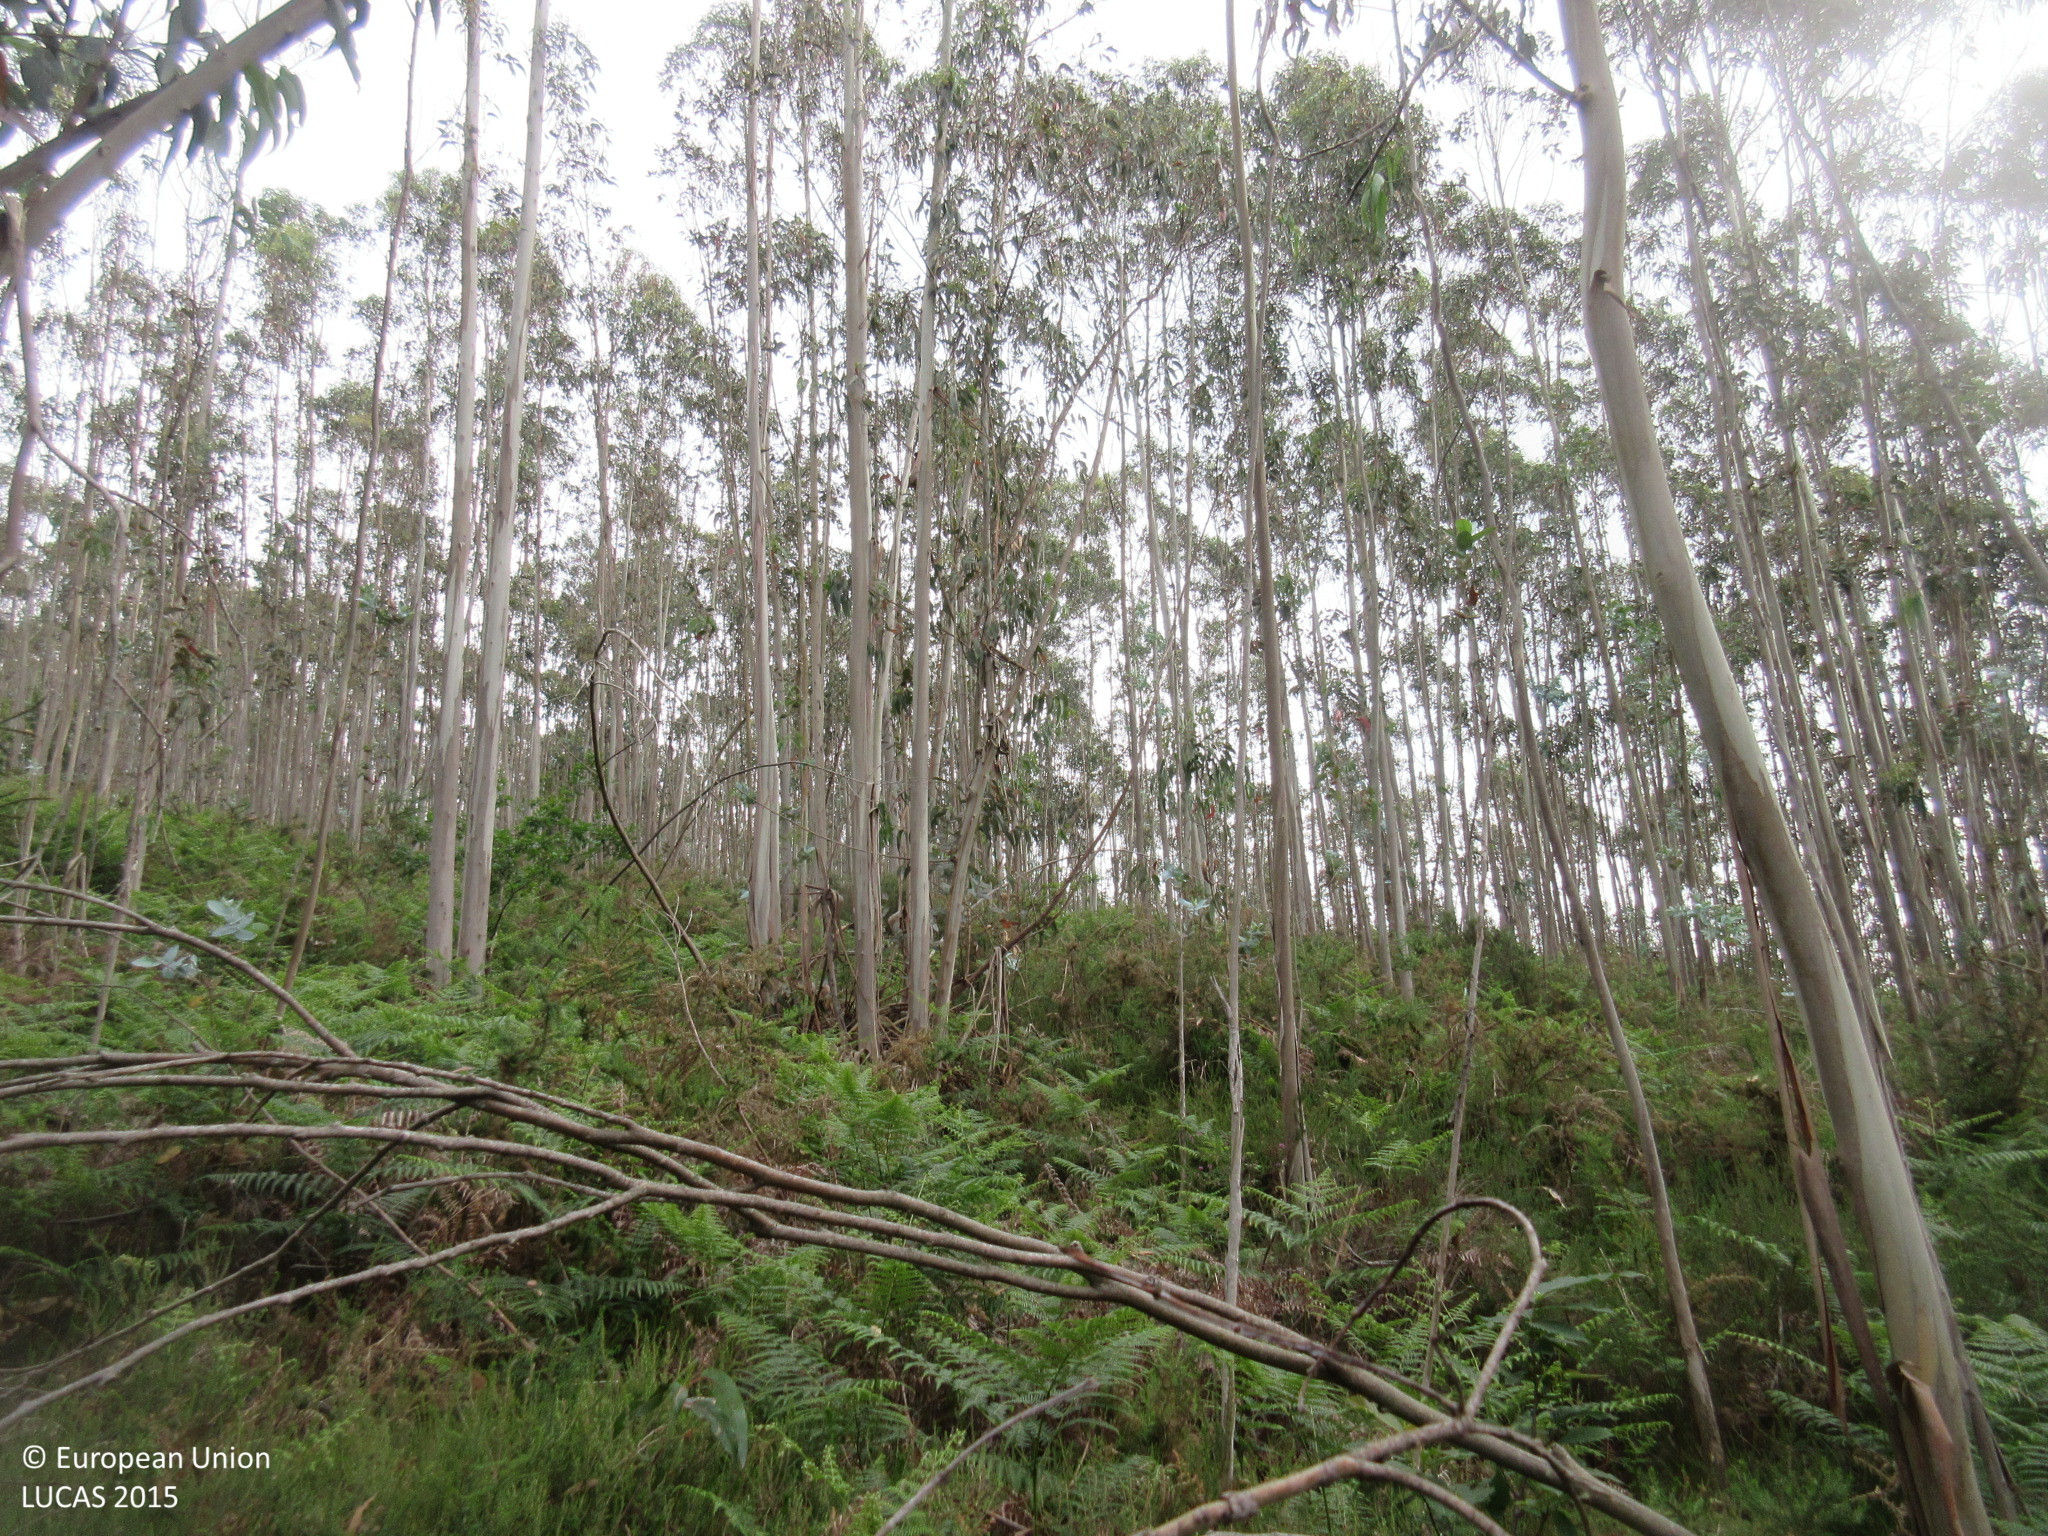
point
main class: Woodland
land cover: Broadleaved woodland
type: exotic forest
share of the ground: > 75 %
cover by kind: broadleaved forest trees 85 %, shrubs 15 %
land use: Forestry
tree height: > 5 m
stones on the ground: 10 - 25 %
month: June
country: ES
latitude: 43.4389
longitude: -5.9422
